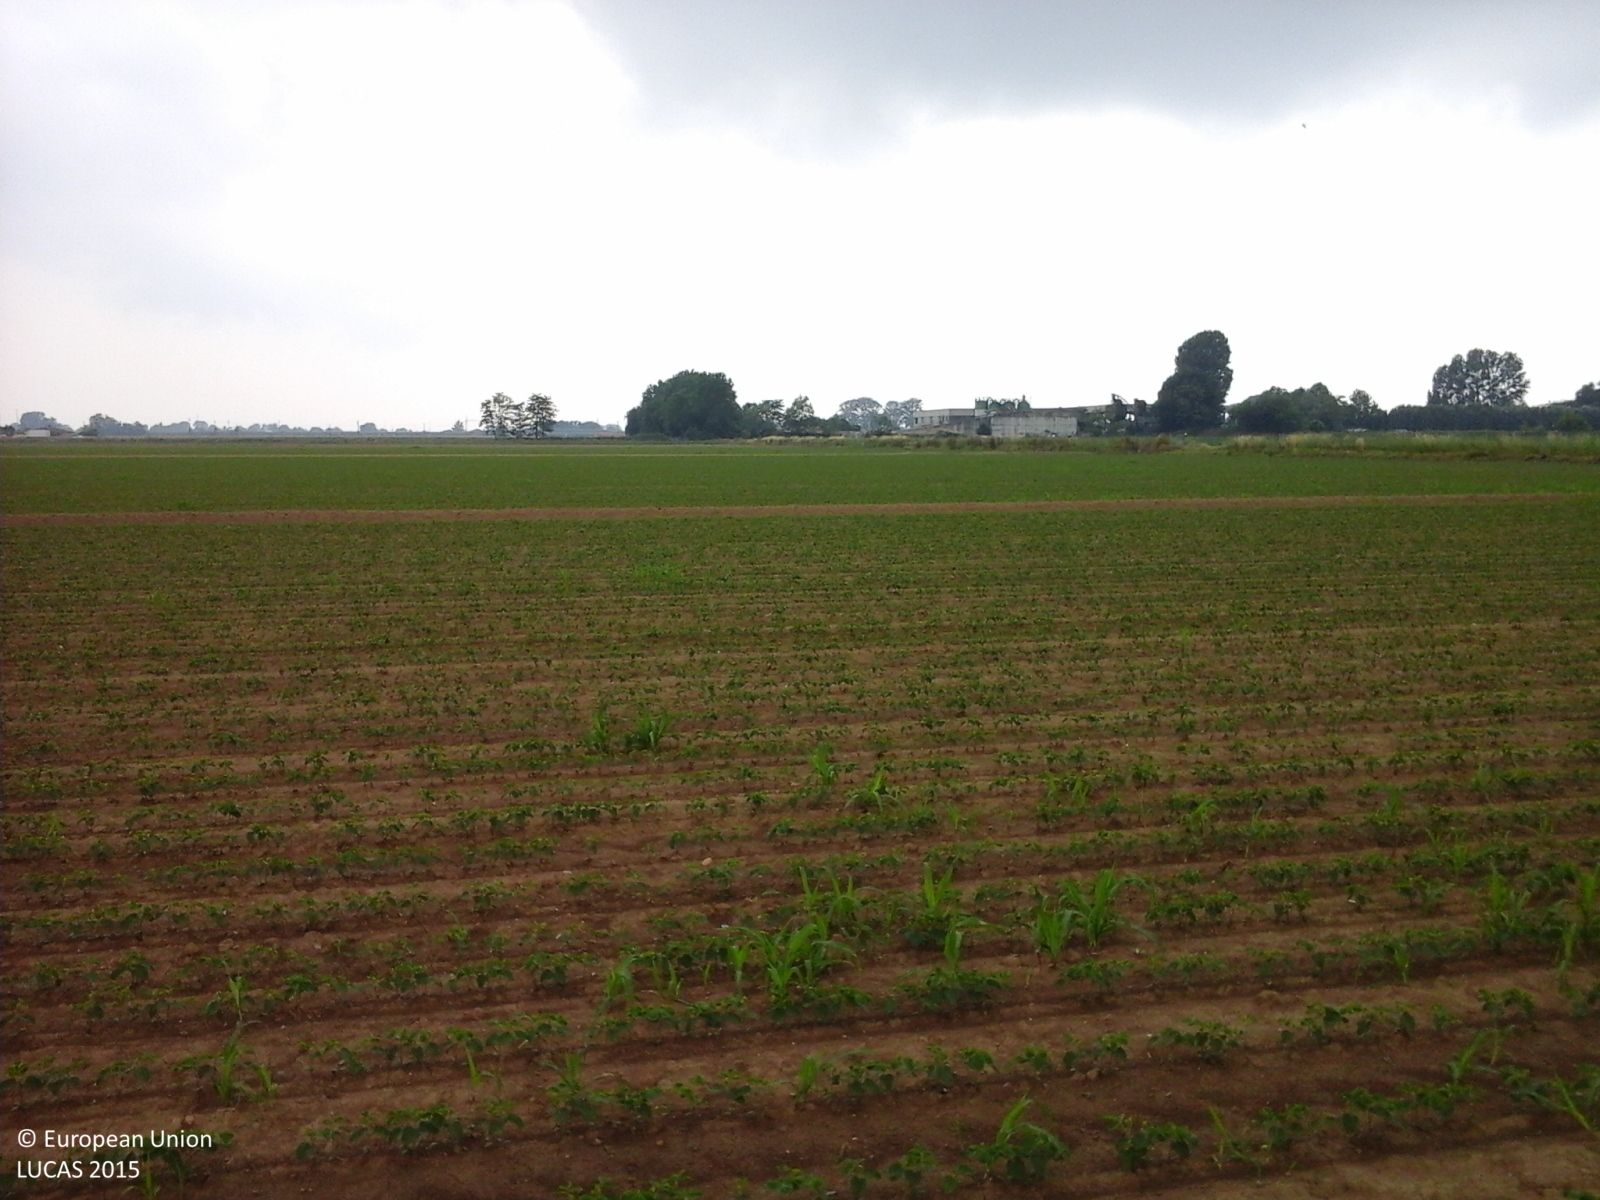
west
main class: Cropland
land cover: Soya
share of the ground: < 10 %
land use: Agriculture (excluding fallow land and kitchen gardens)
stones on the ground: < 10 %
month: May
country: IT
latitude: 45.4669
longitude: 9.4510
